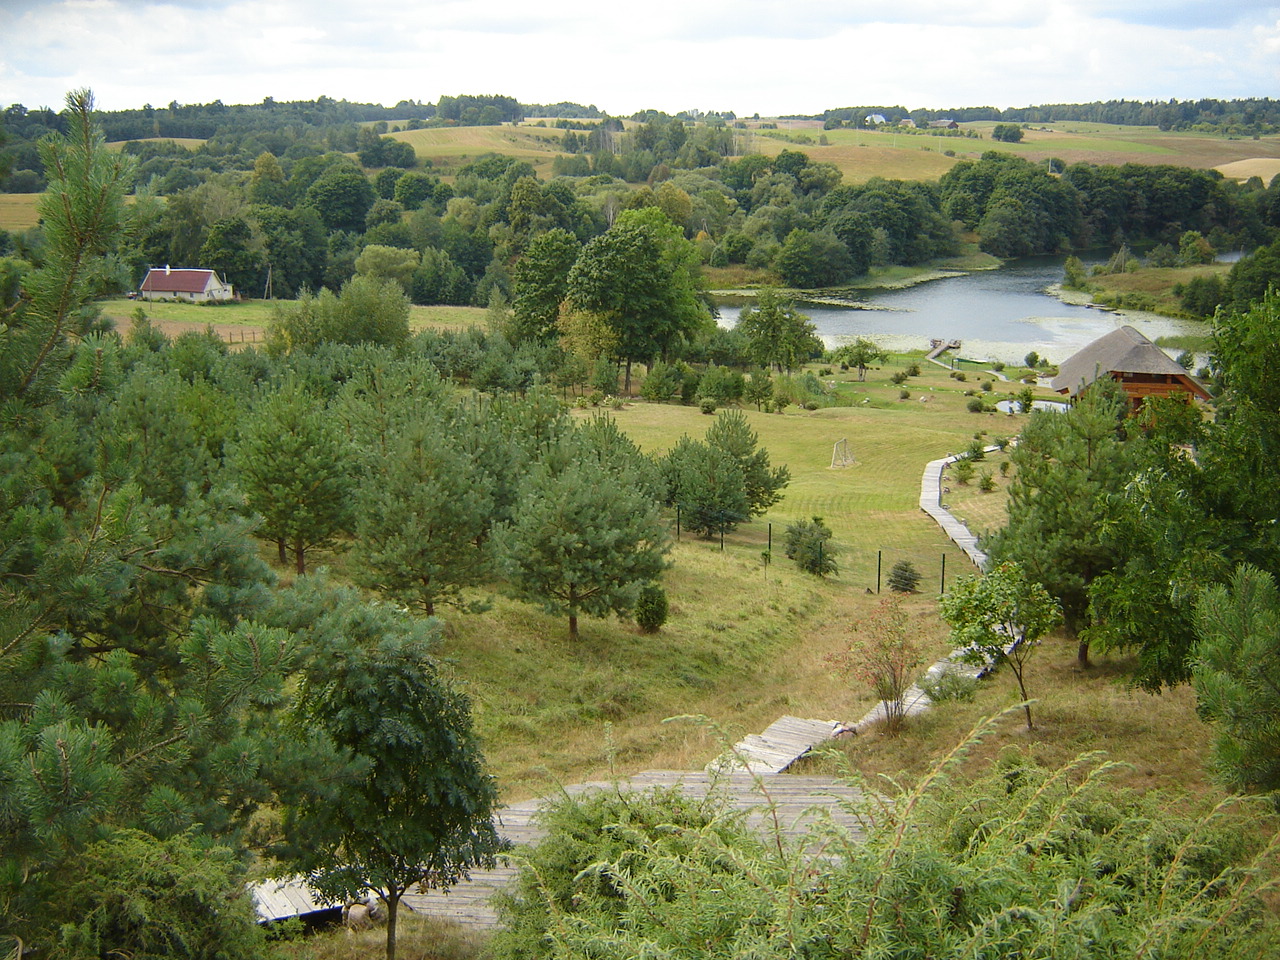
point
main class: Woodland
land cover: Pine dominated coniferous woodland
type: hemiboreal forest and nemoral coniferous forest and mixed broadleaved-coniferous forest
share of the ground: 50 - 75 %
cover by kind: coniferous forest trees 50 %, herbaceous plants 40 %, broadleaved forest trees 5 %, shrubs 5 %
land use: Residential
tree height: > 5 m
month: August
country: LT
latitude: 54.6191
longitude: 24.7114
